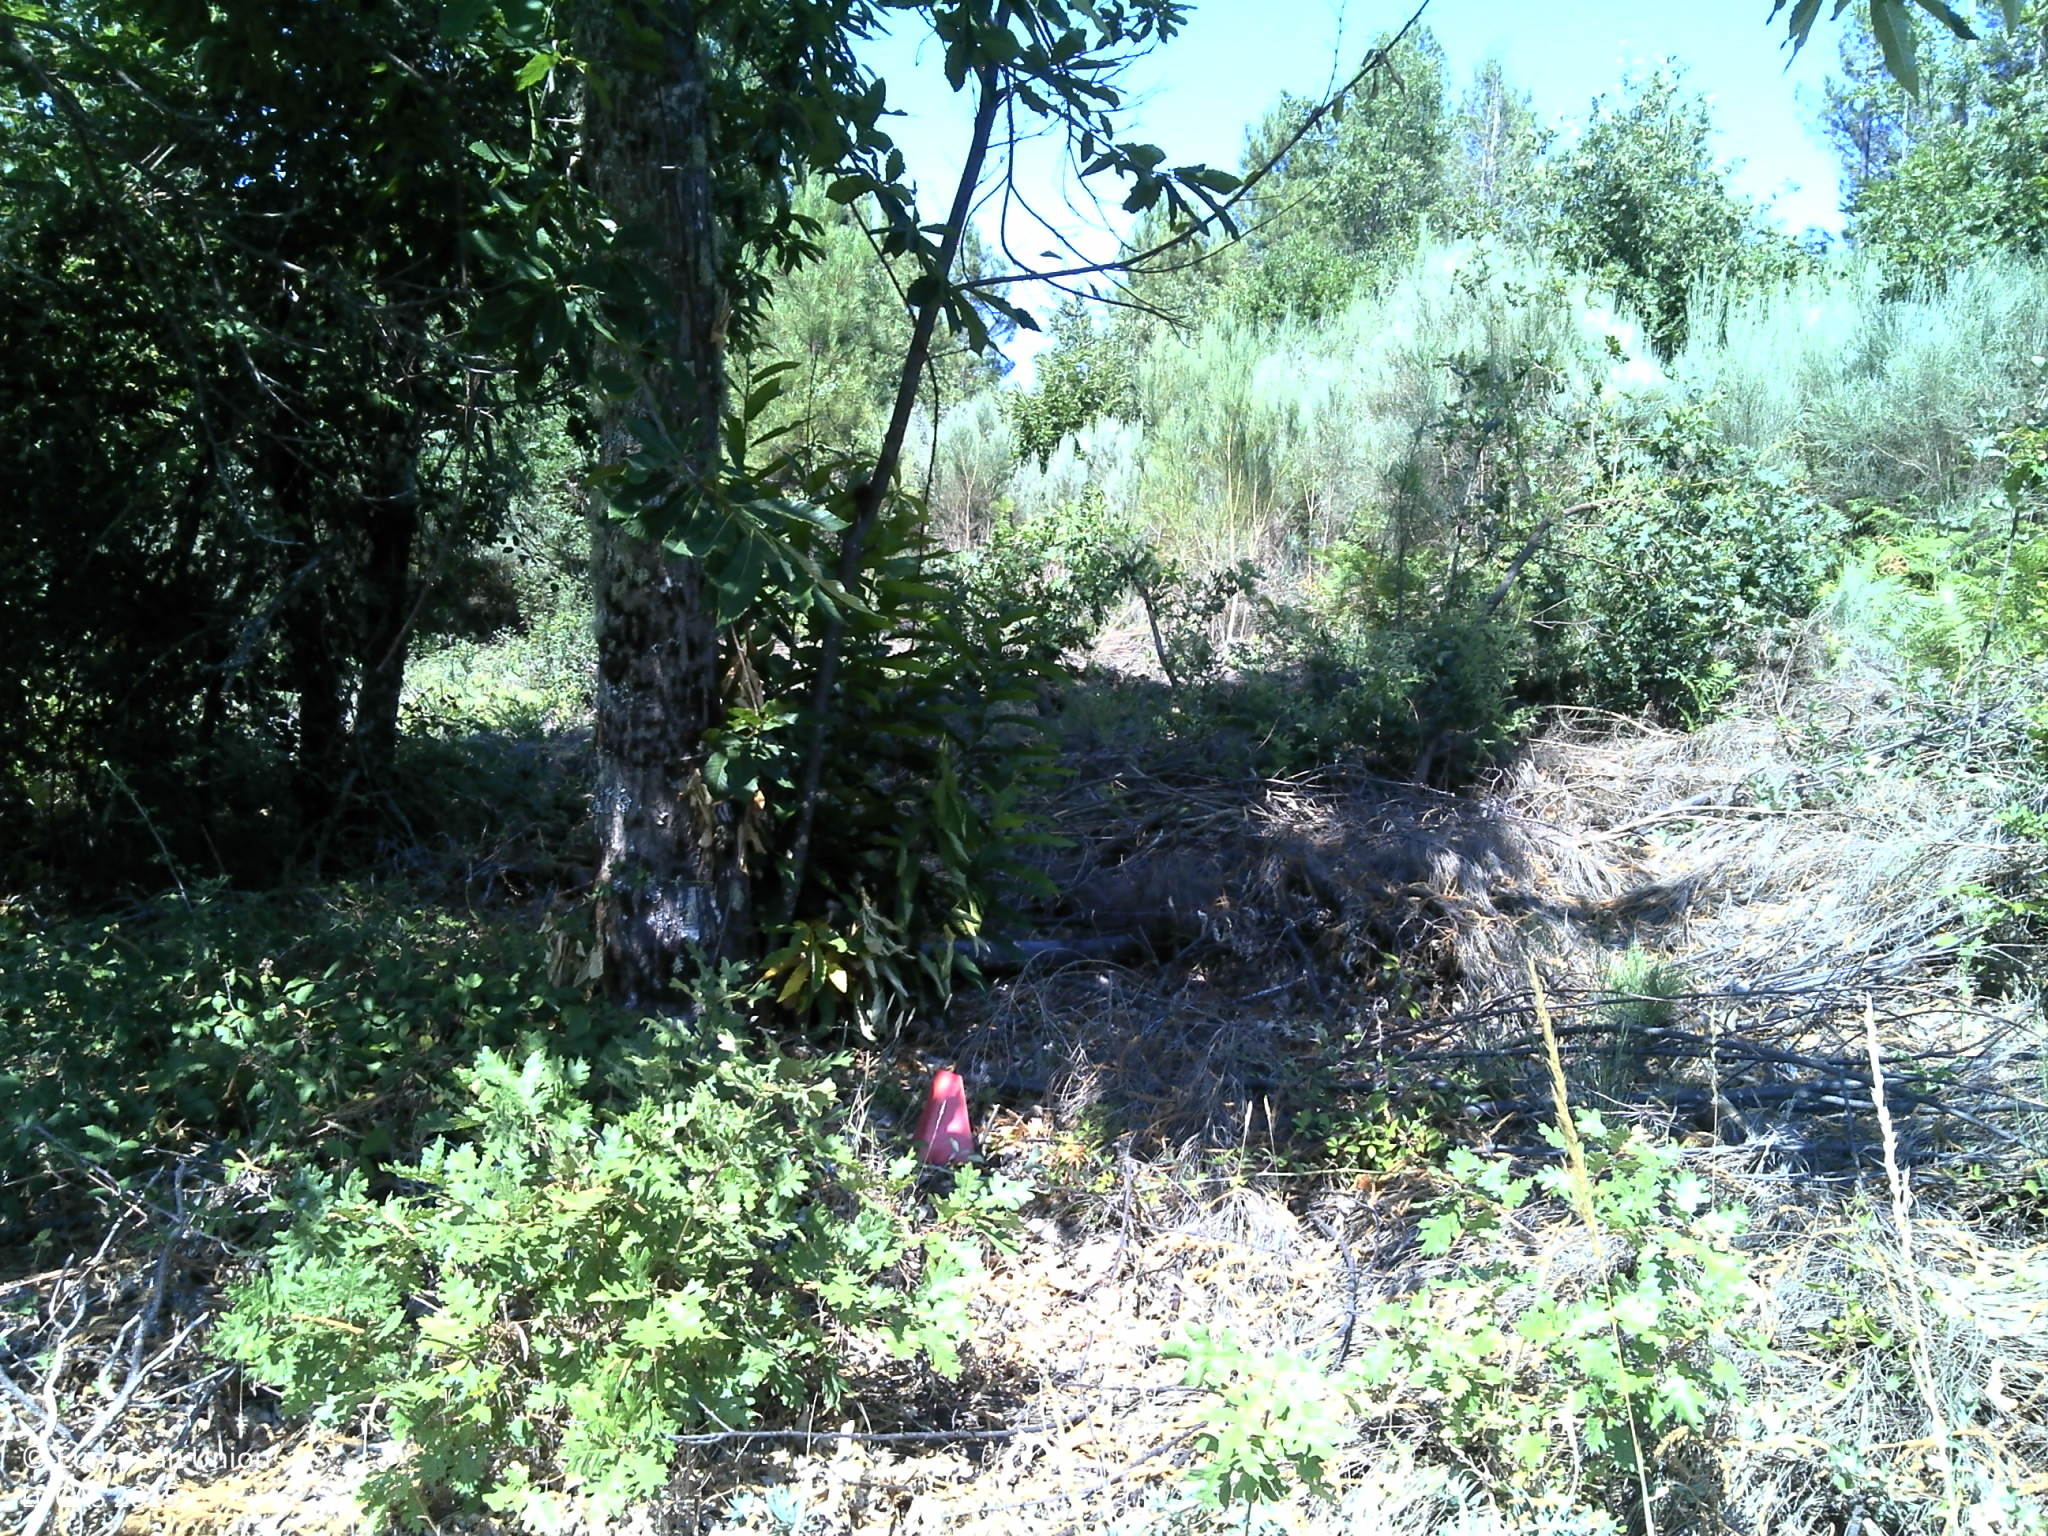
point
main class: Cropland
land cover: Nuts trees
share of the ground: < 10 %
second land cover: Shrubland without tree cover
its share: 25 - 50 %
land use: Agriculture (excluding fallow land and kitchen gardens)
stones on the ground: 25 - 50 %
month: July
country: PT
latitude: 40.8589
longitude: -7.4965
